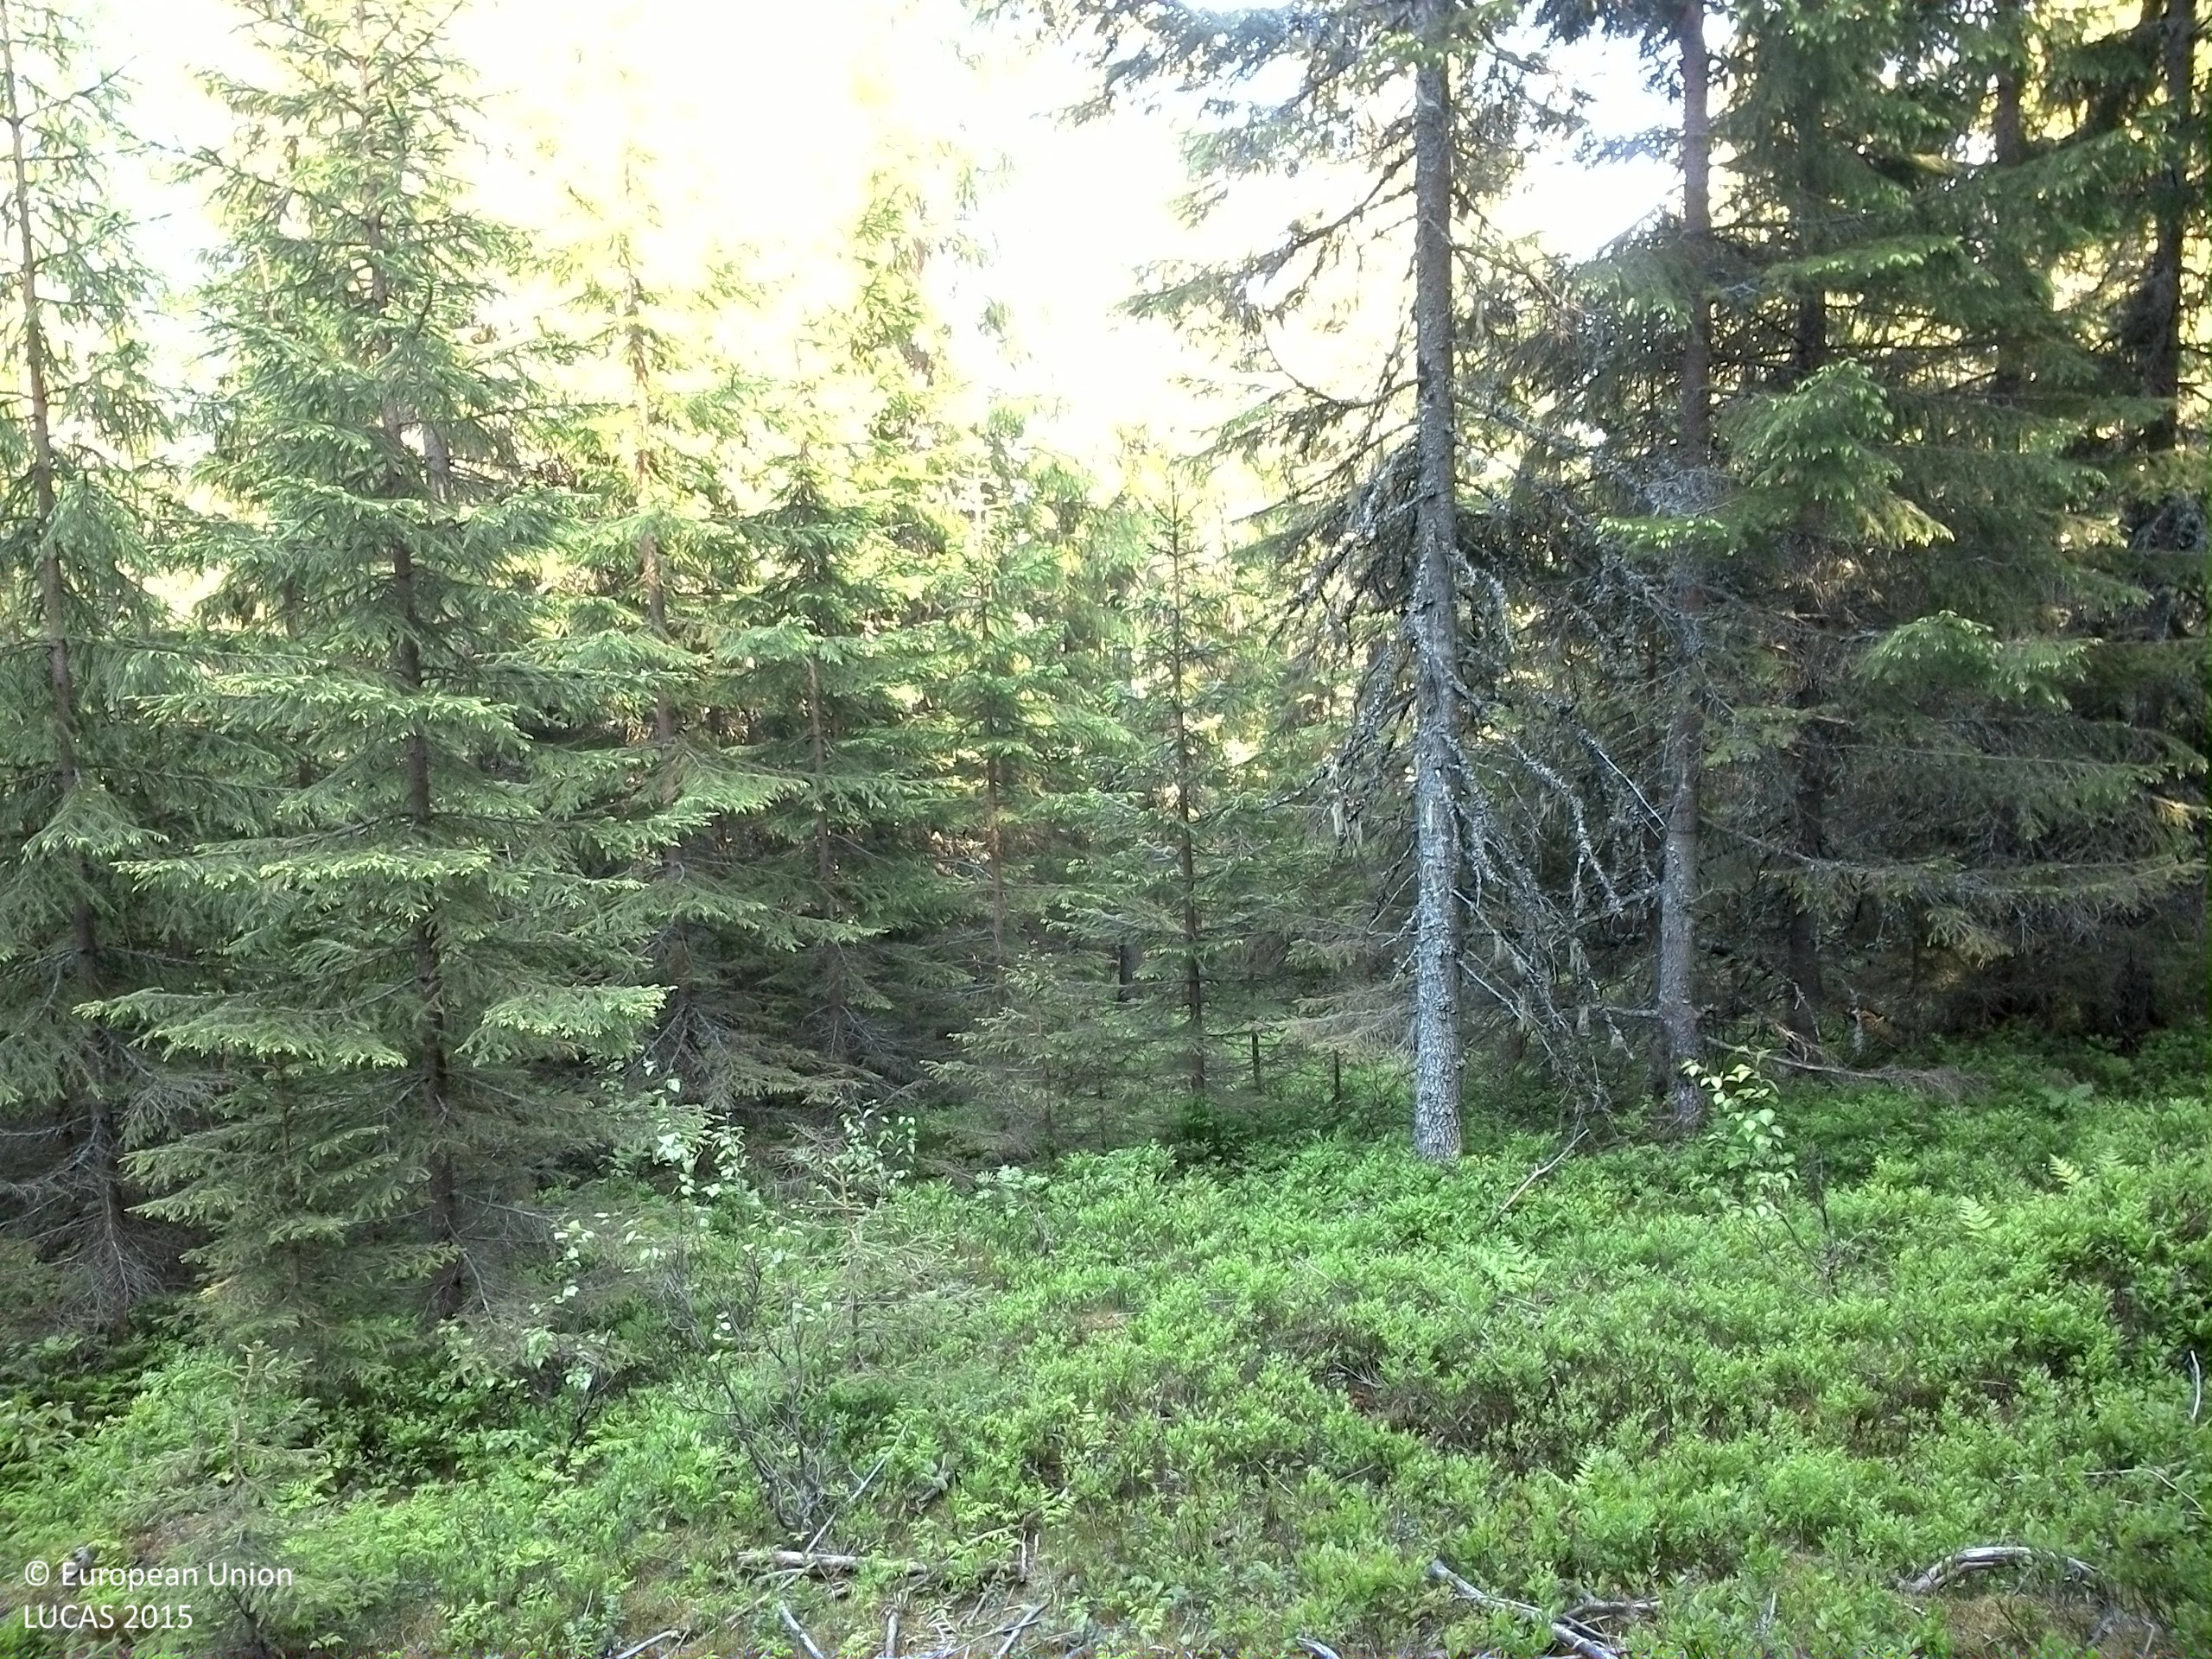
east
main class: Woodland
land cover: Spruce dominated coniferous woodland
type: boreal forest
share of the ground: 50 - 75 %
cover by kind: coniferous forest trees 60 %, shrubs 35 %, broadleaved forest trees 5 %
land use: Forestry
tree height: > 5 m
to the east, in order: Spruce dominated coniferous woodland; Tracks; Spruce dominated coniferous woodland; Rivers and streams; Spruce dominated coniferous woodland; Tracks; Spruce dominated coniferous woodland
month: June
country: SE
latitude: 62.7570
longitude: 17.7528
